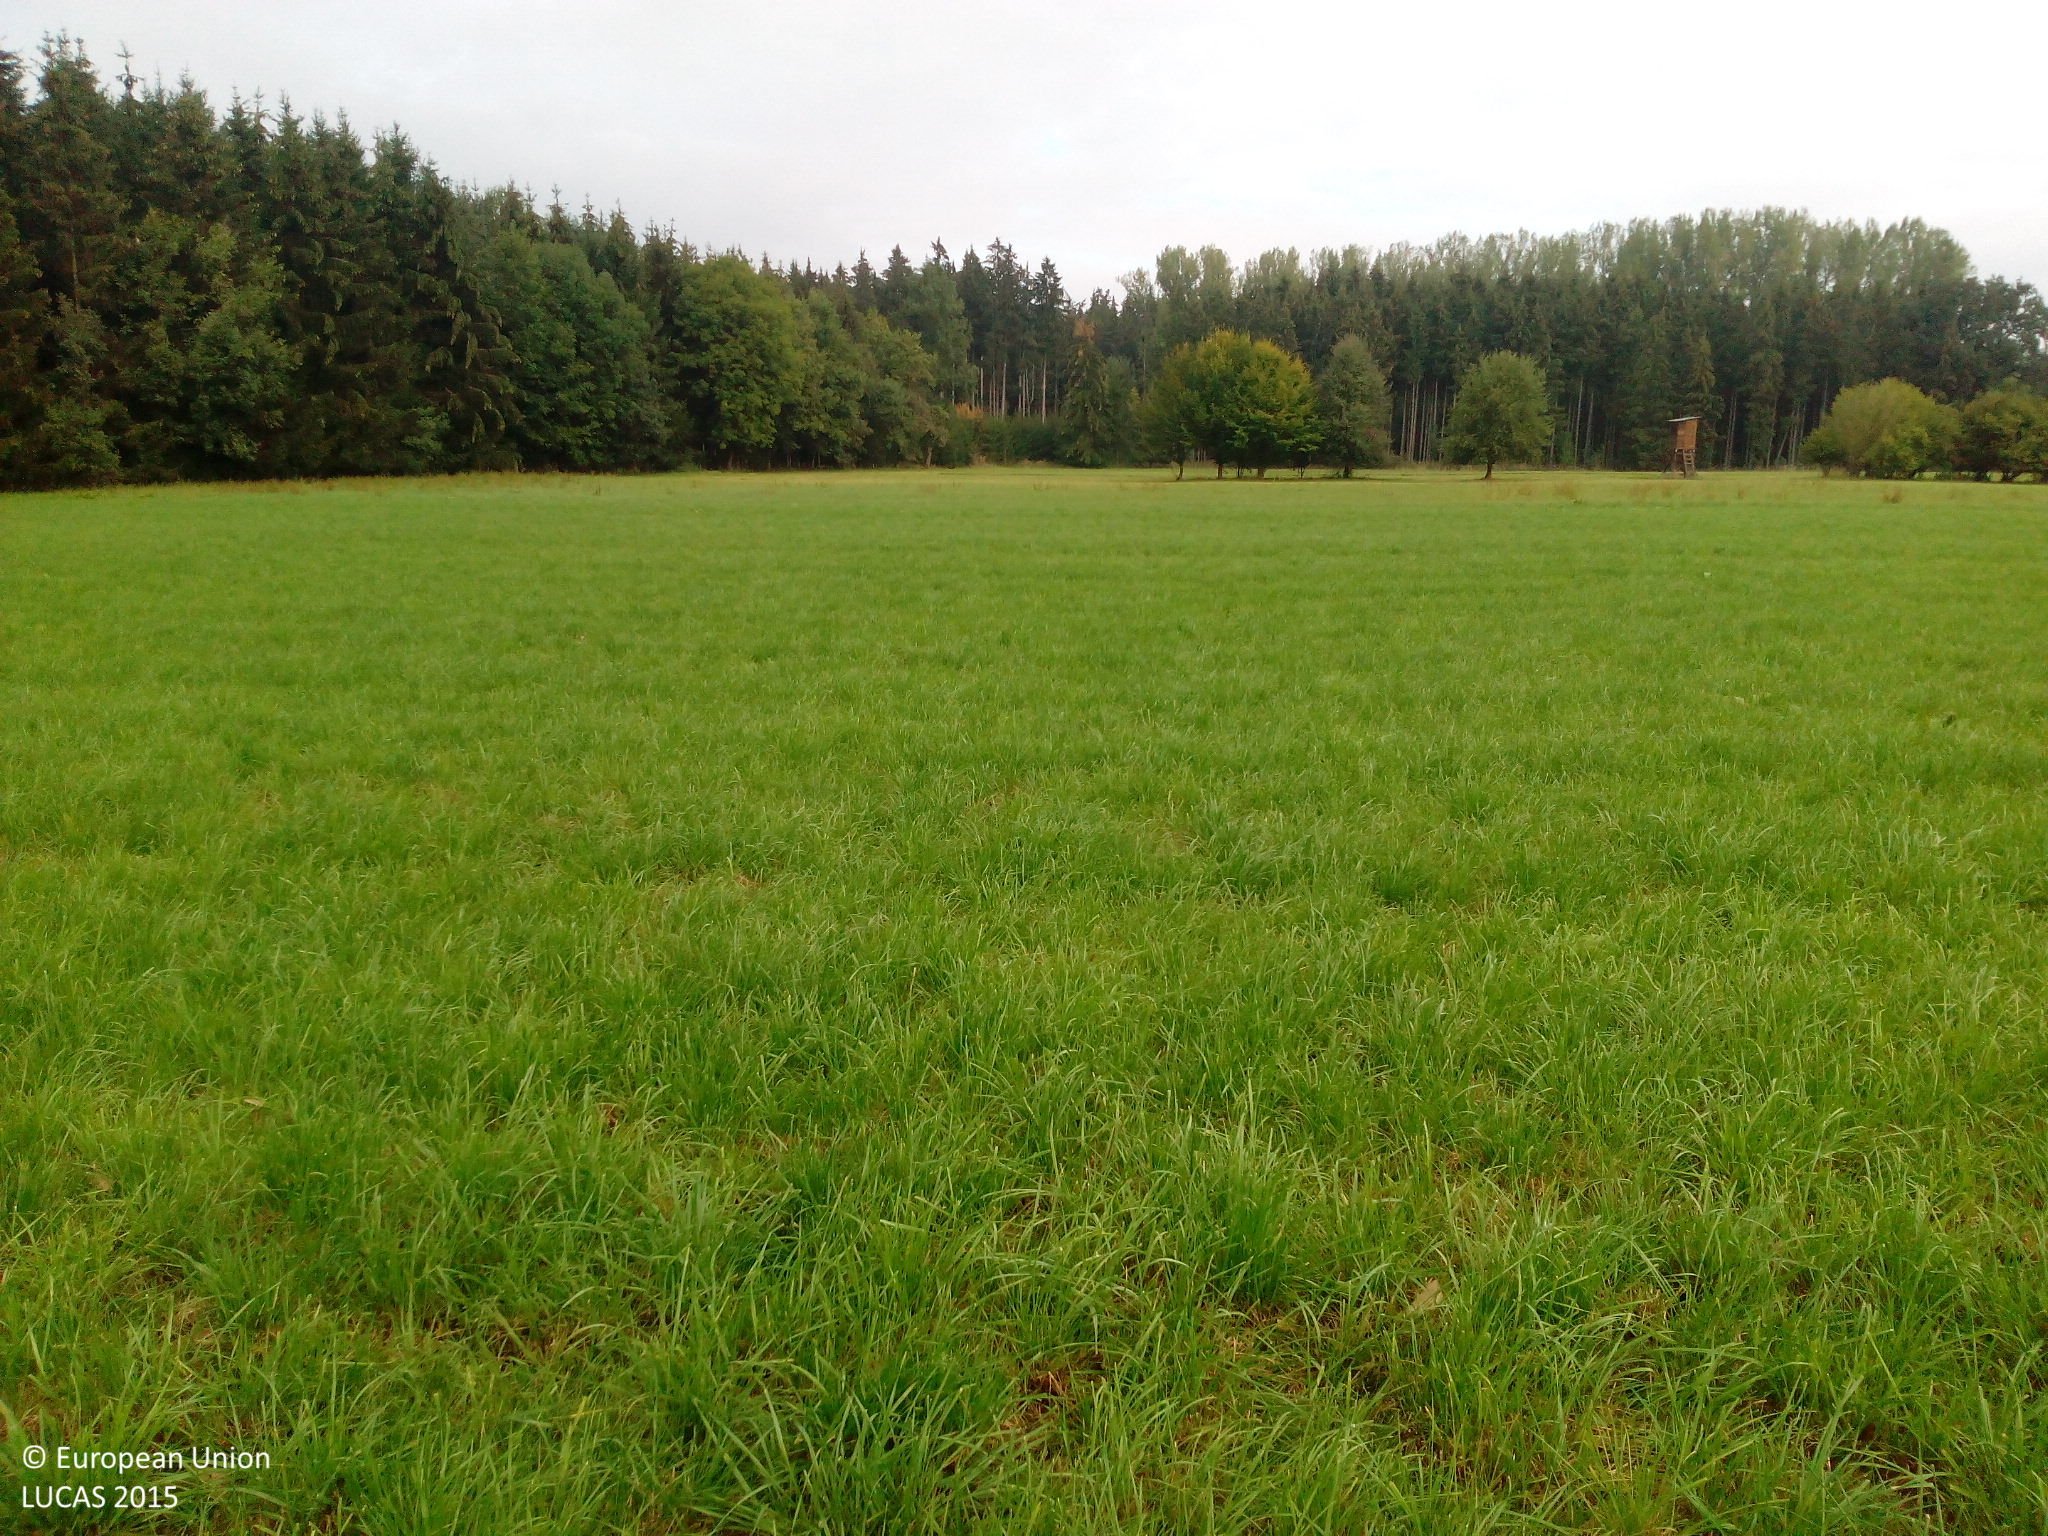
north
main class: Grassland
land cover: Grassland without tree/shrub cover
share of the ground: > 75 %
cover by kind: herbaceous plants 95 %, unconsolidated bare surface 5 %
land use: Agriculture (excluding fallow land and kitchen gardens)
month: September
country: DE
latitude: 48.3757
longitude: 11.4708
